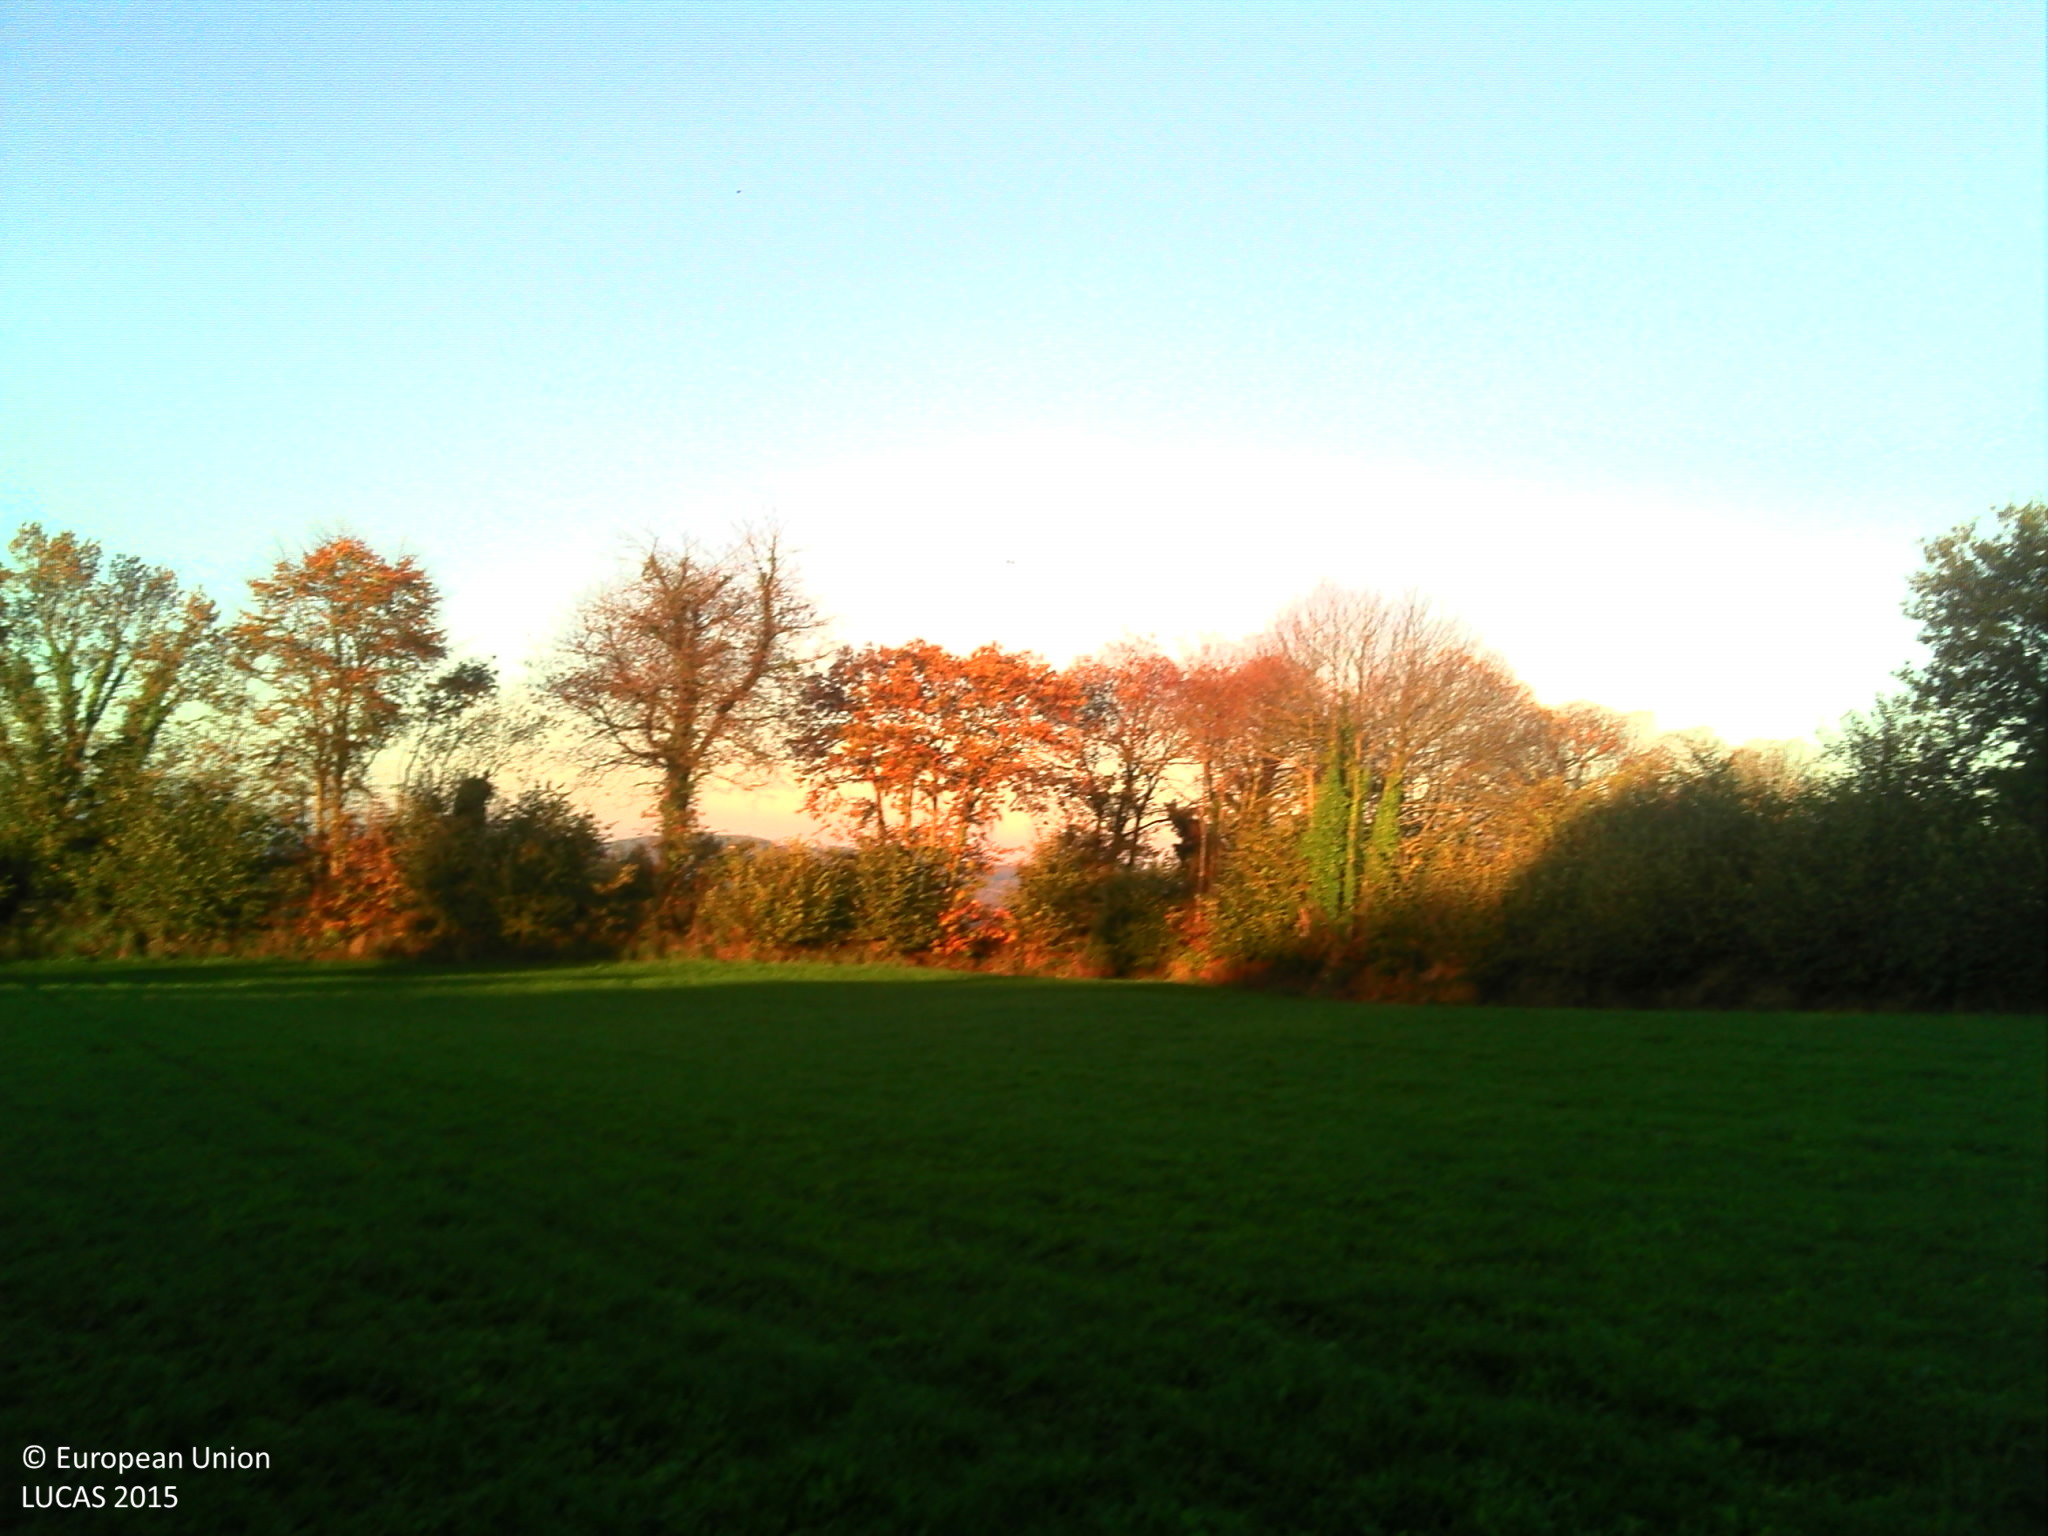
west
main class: Cropland
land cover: Temporary grasslands
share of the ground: > 75 %
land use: Agriculture (excluding fallow land and kitchen gardens)
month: November
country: FR
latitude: 48.1053
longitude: -3.6030
